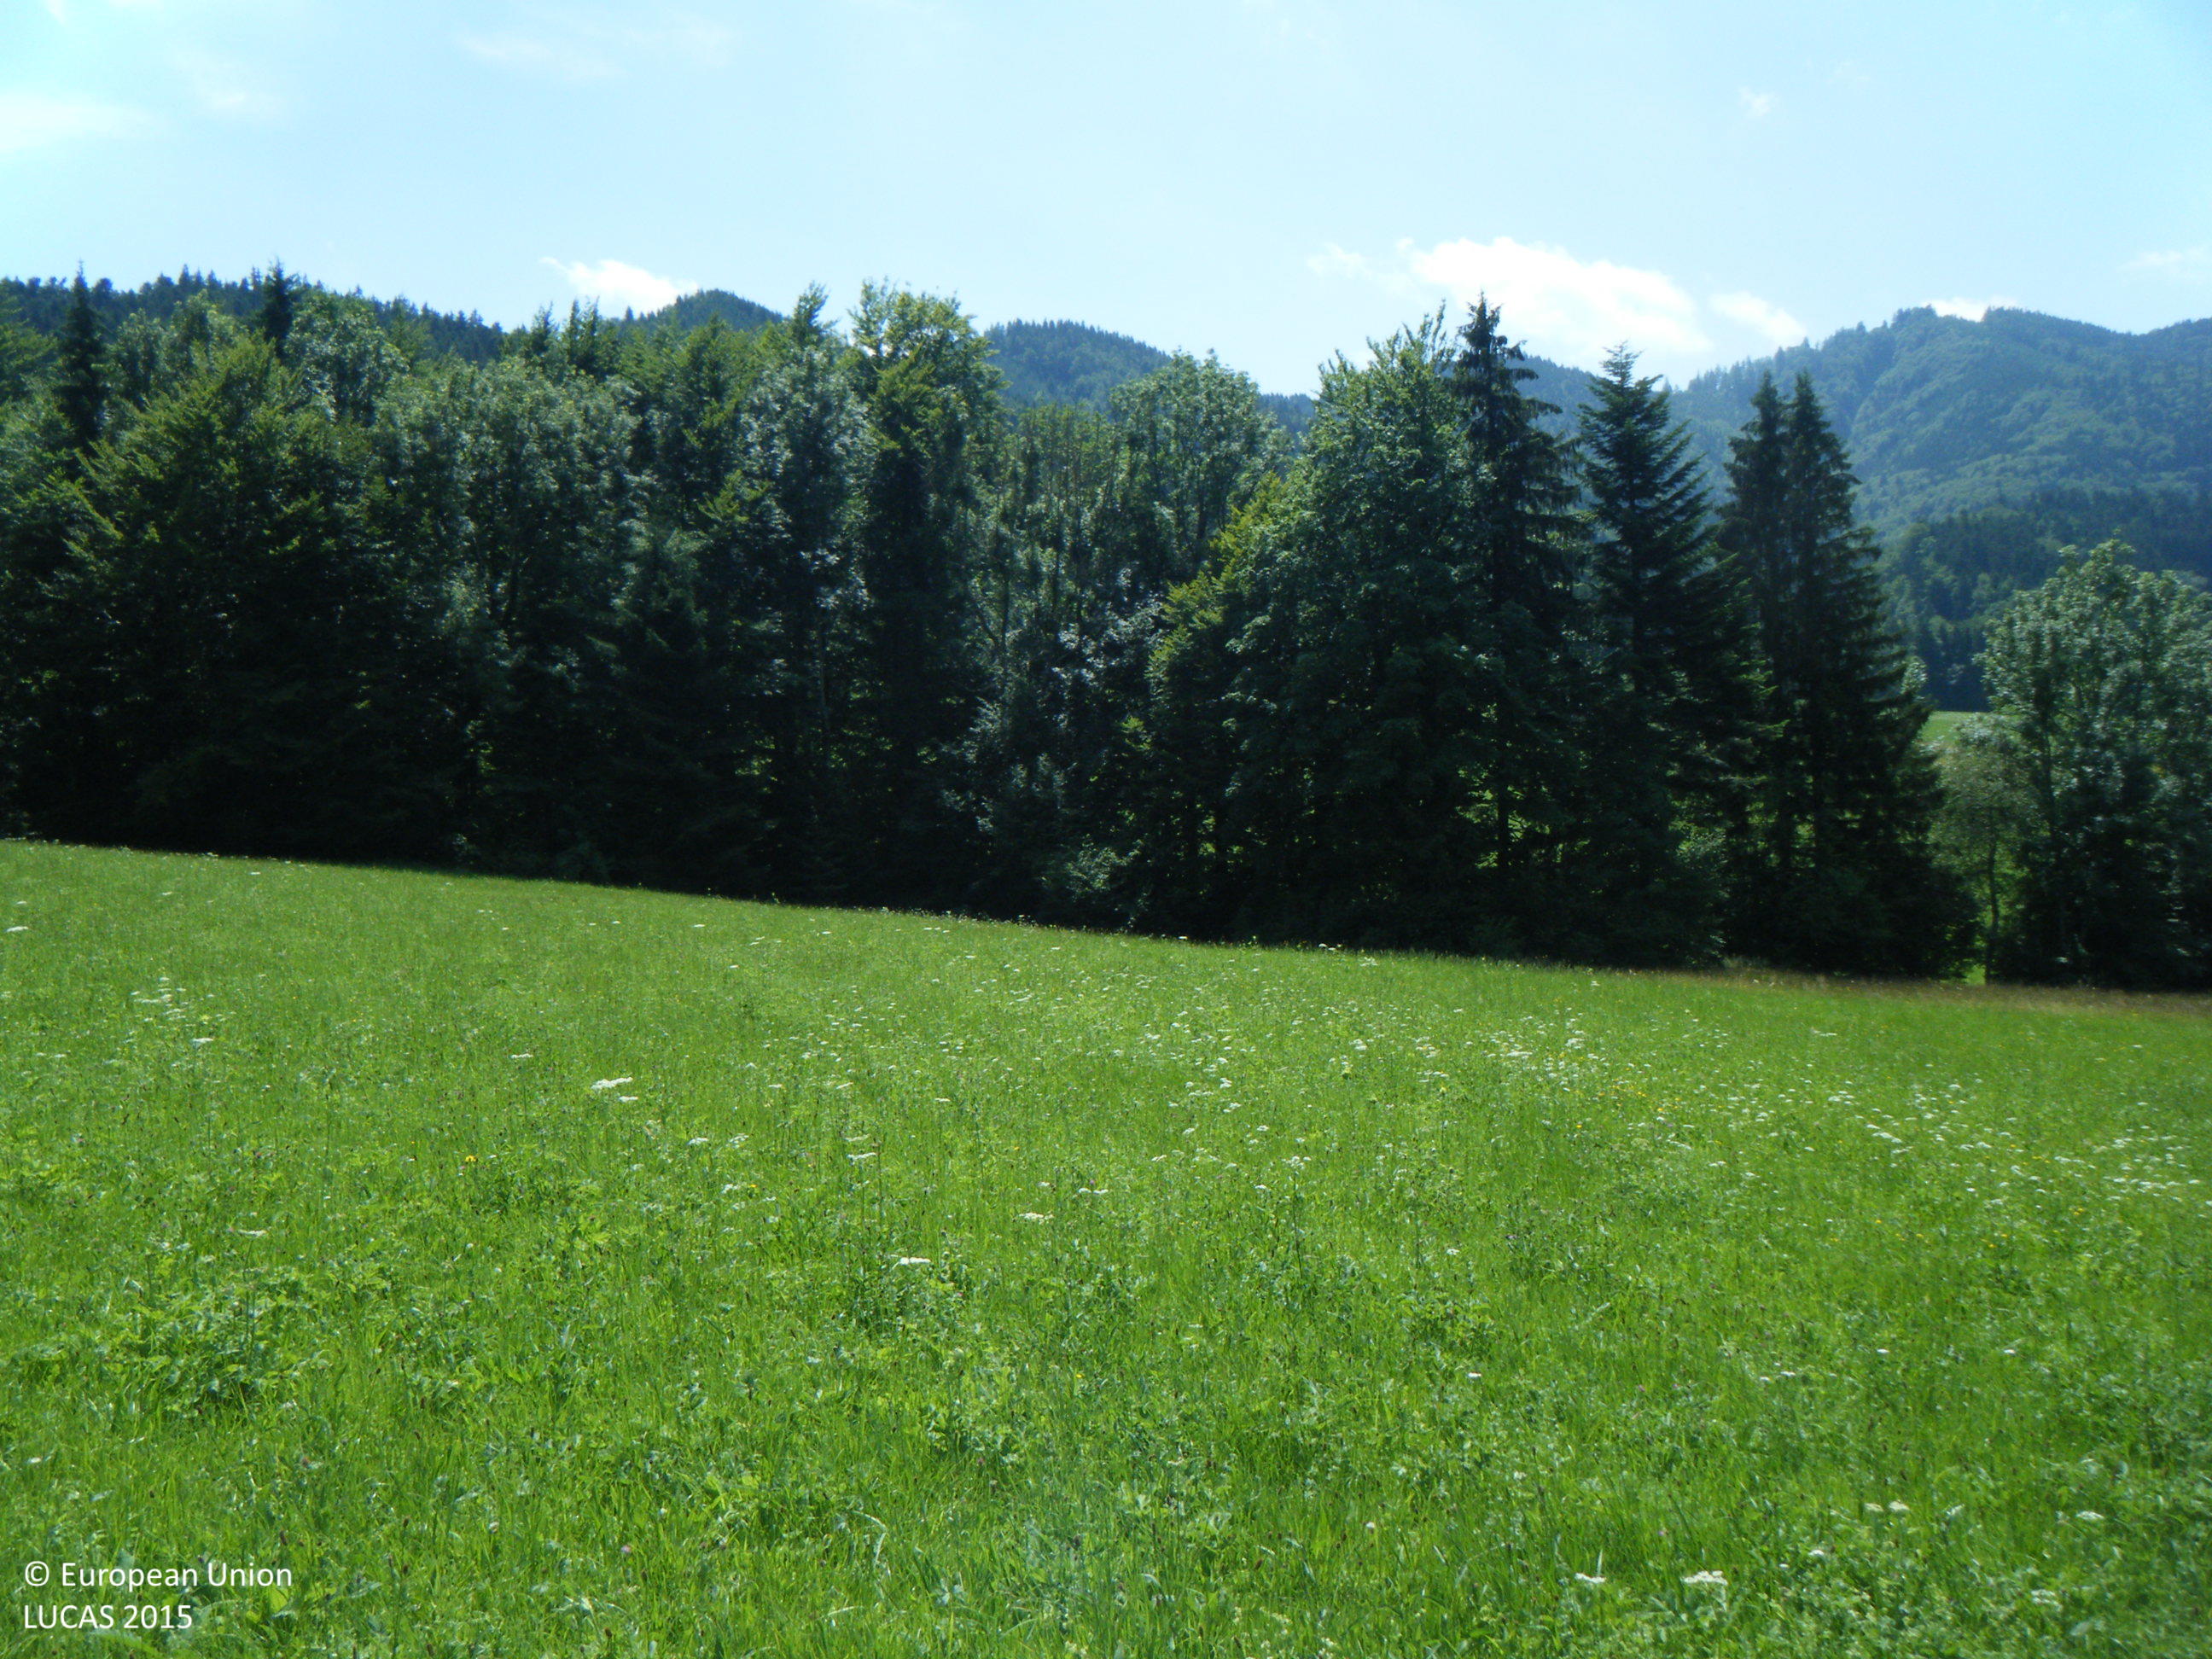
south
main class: Grassland
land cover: Grassland without tree/shrub cover
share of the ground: > 75 %
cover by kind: herbaceous plants 100 %
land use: Agriculture (excluding fallow land and kitchen gardens)
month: July
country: AT
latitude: 47.8442
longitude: 13.4864
